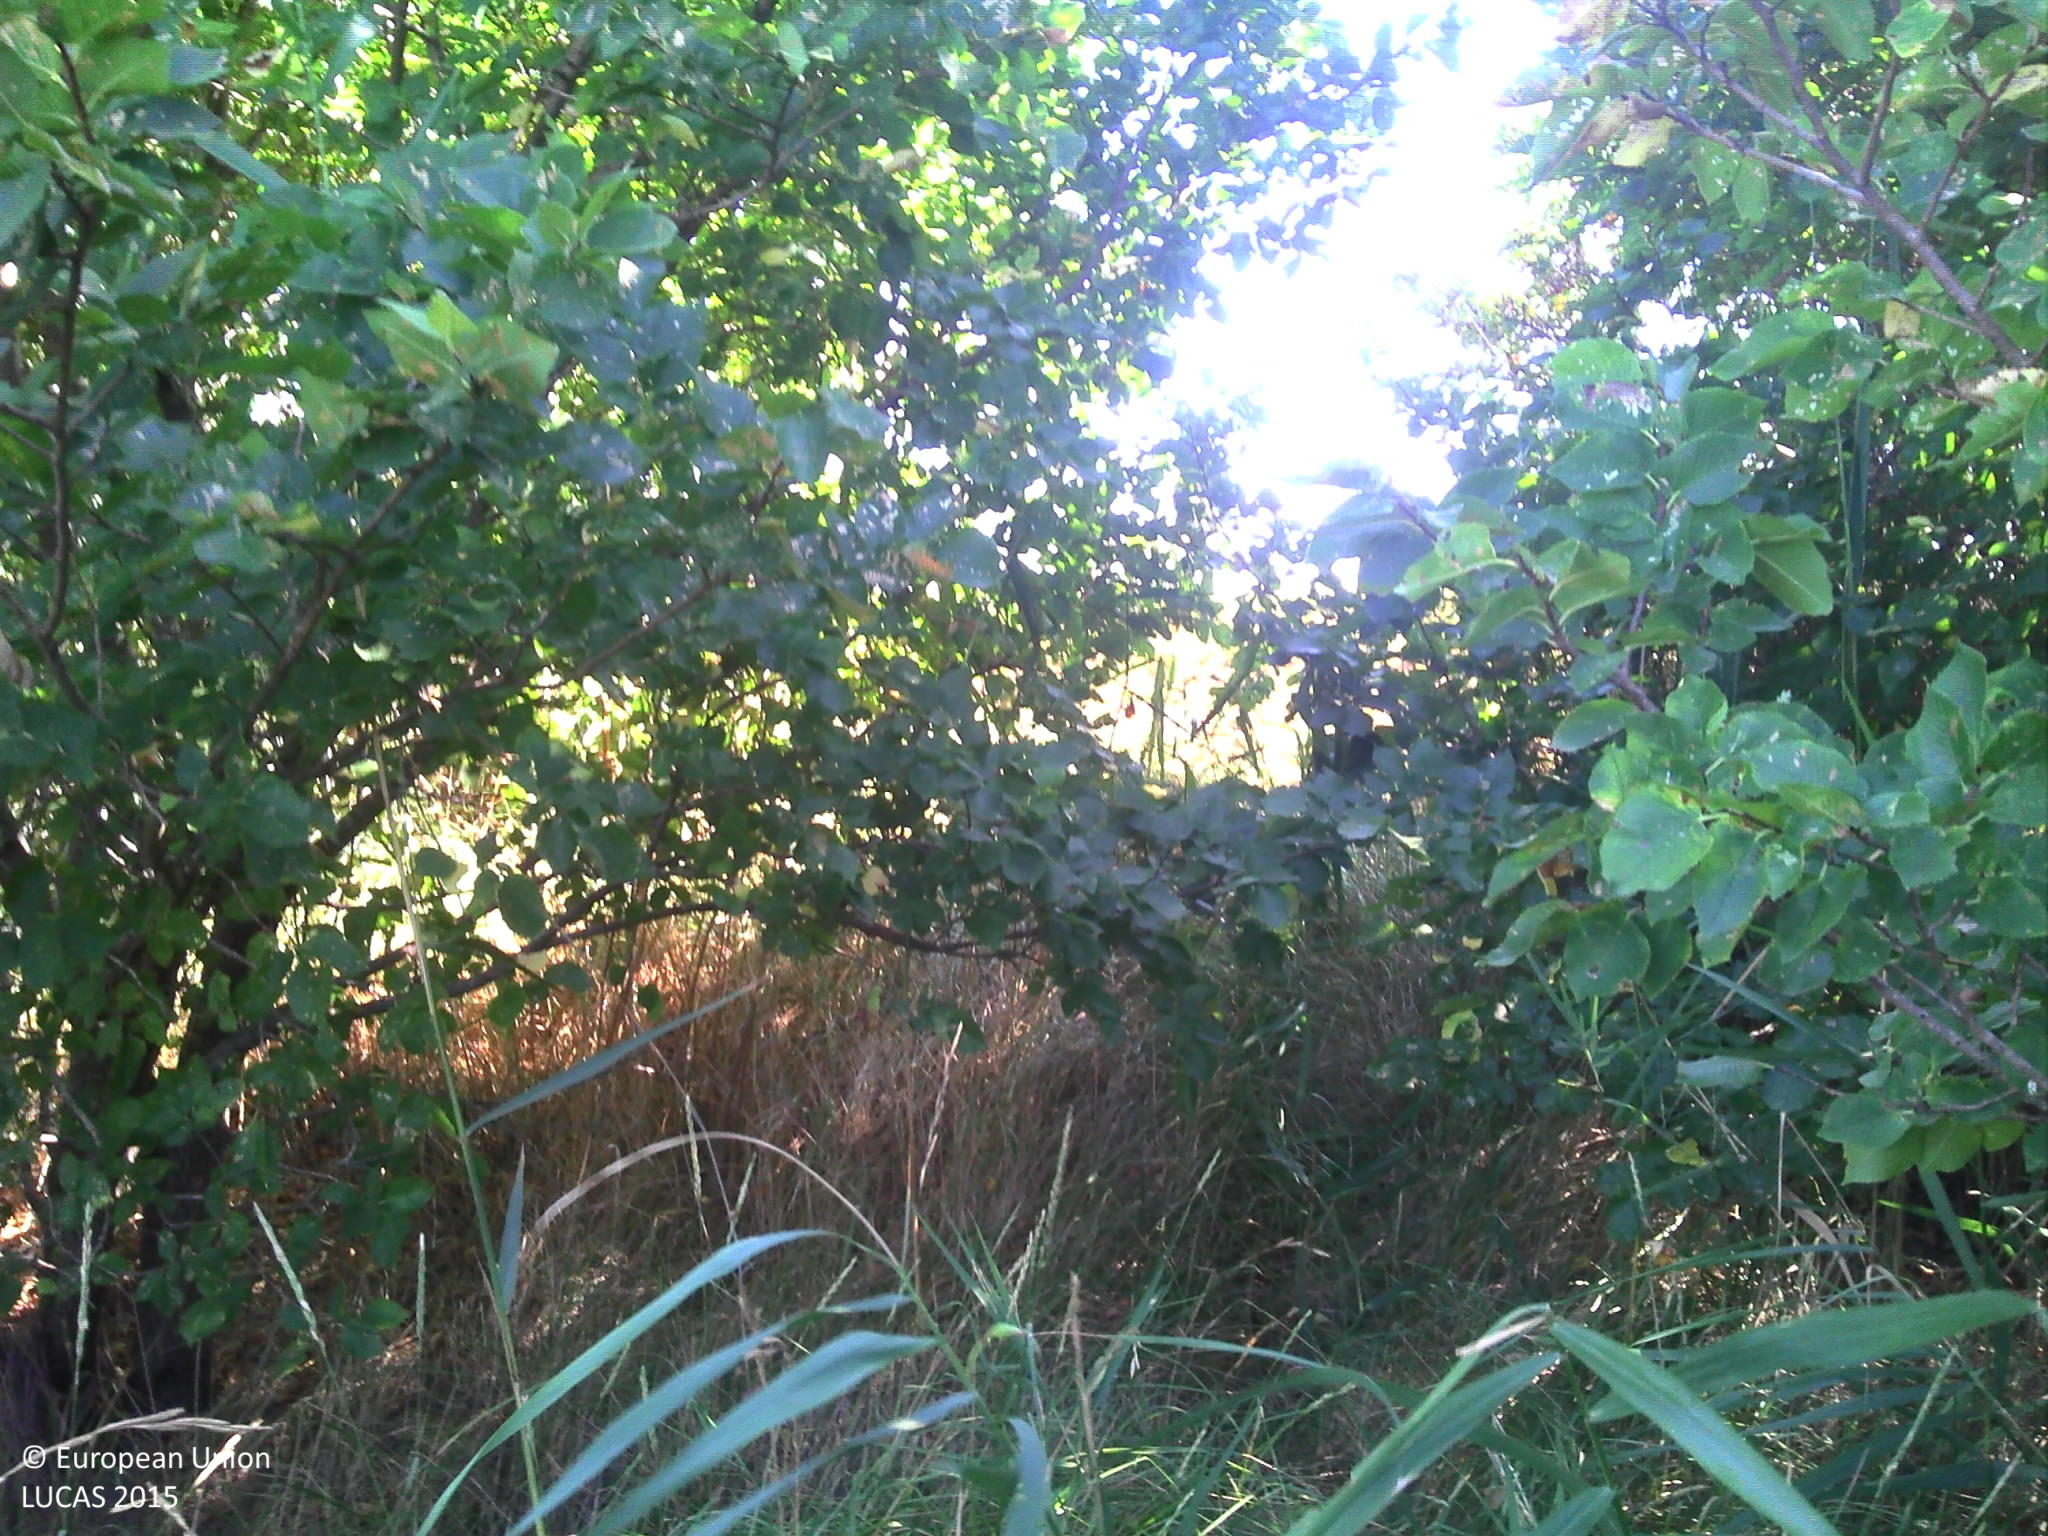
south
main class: Grassland
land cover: Spontaneously vegetated surfaces
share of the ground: 50 - 75 %
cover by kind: herbaceous plants 50 %, shrubs 5 %
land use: Semi-natural and natural areas not in use
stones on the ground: < 10 %
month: July
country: FR
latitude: 43.3881
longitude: 4.7886
